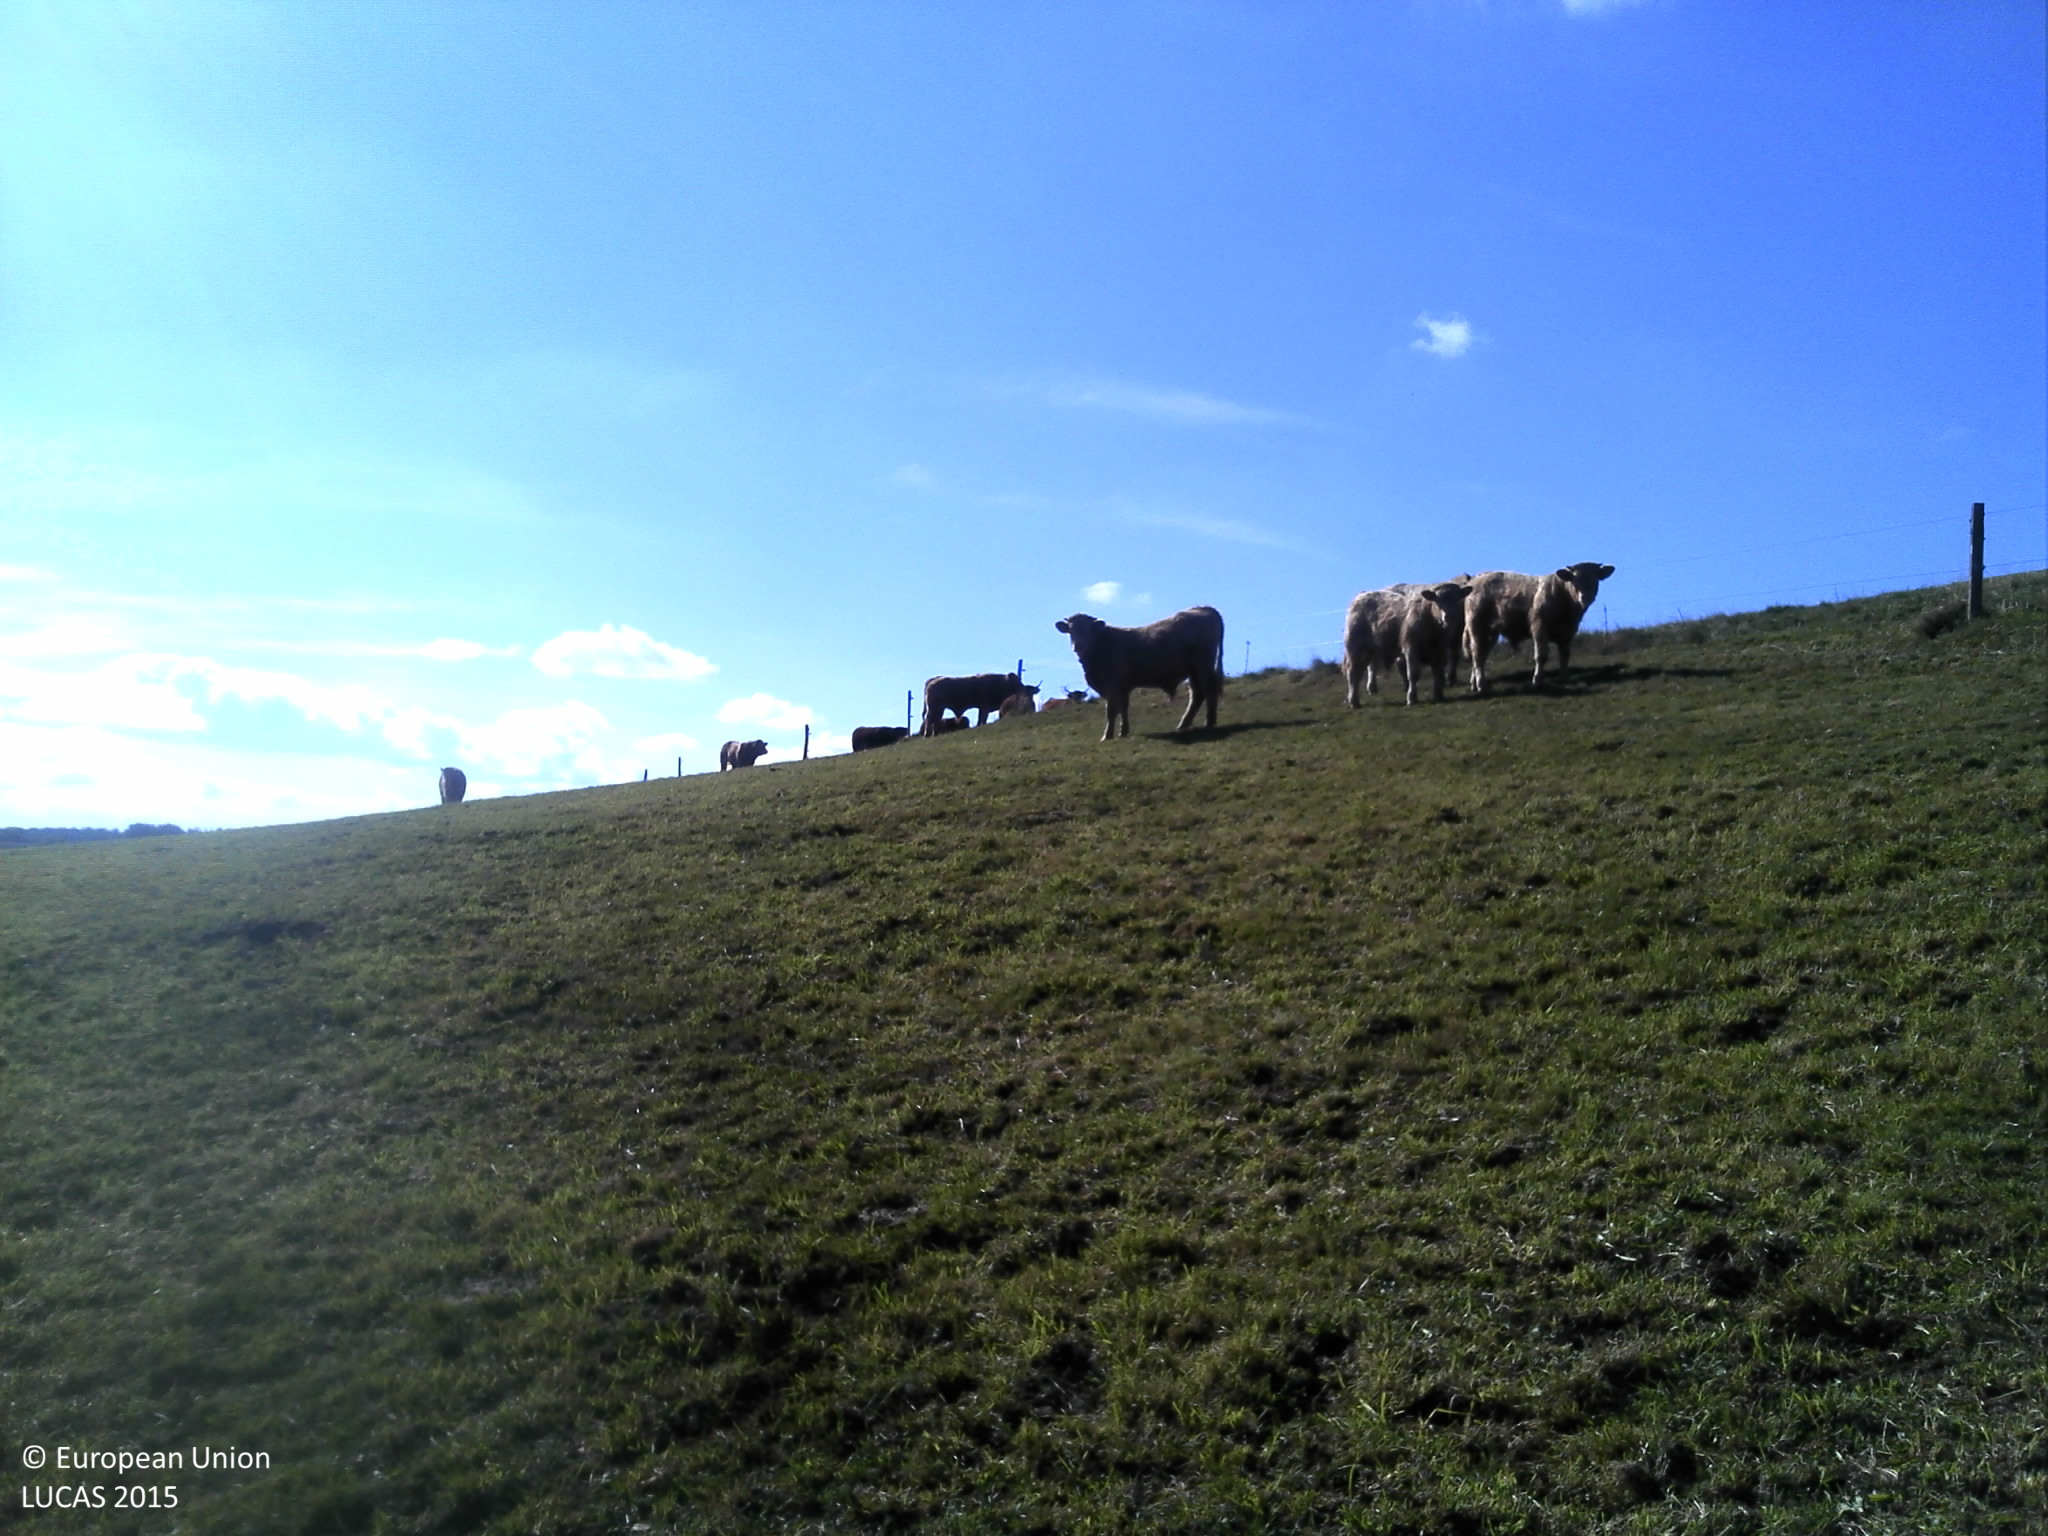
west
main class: Grassland
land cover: Grassland without tree/shrub cover
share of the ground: > 75 %
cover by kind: herbaceous plants 100 %
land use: Agriculture (excluding fallow land and kitchen gardens)
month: September
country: FR
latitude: 45.4788
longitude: 2.8487
